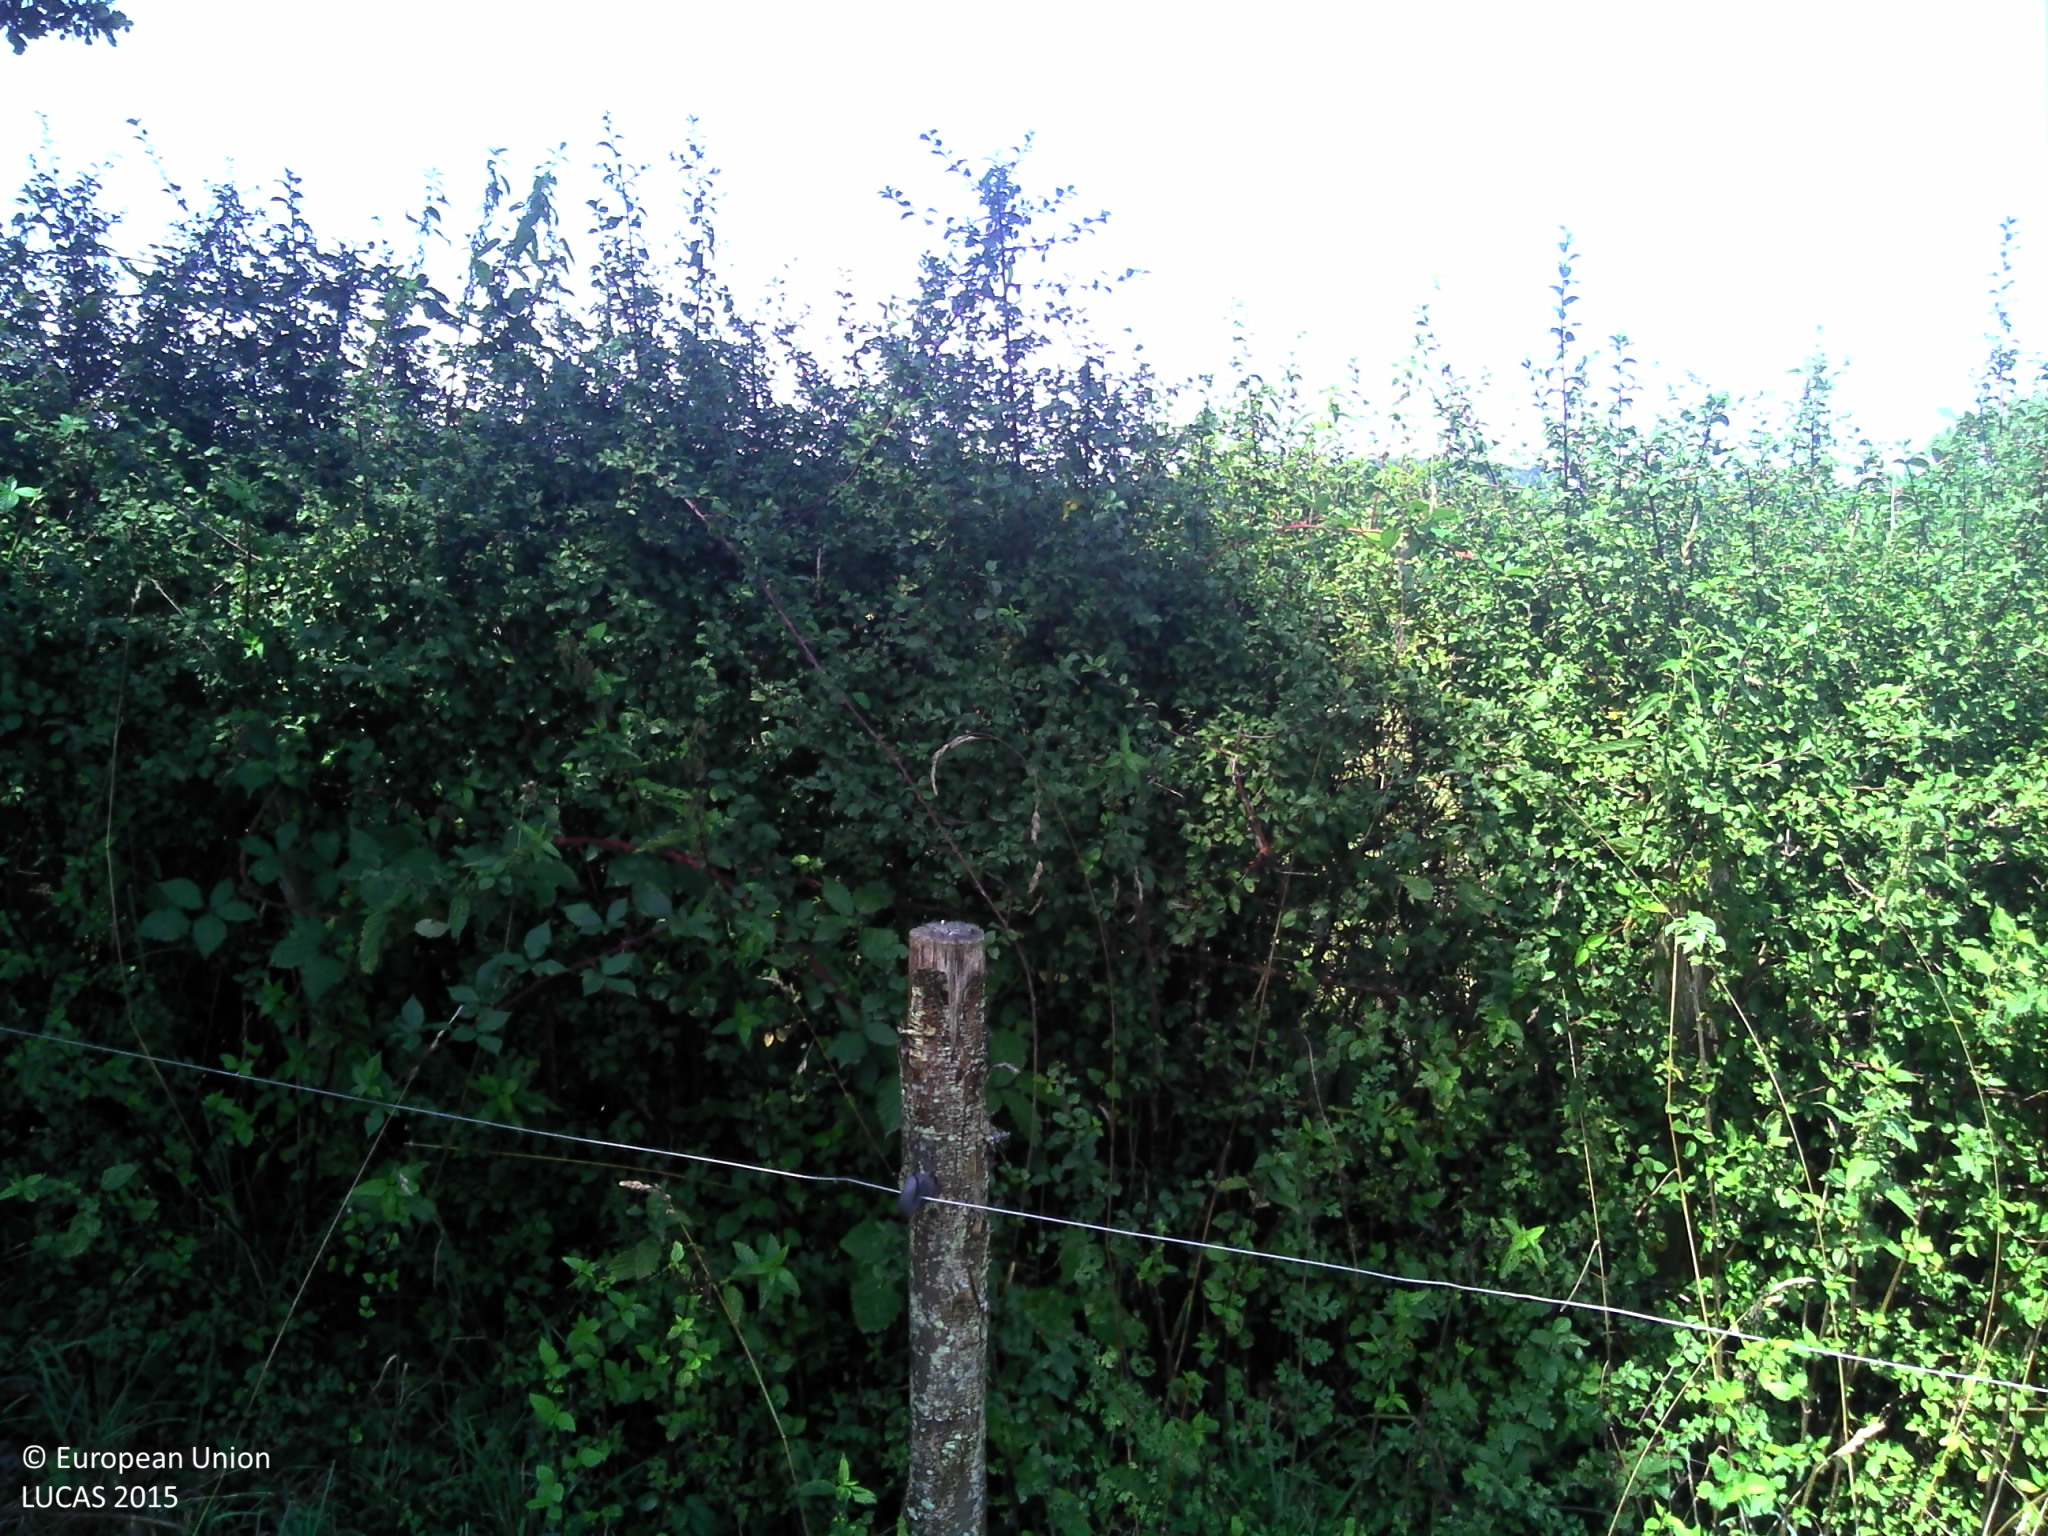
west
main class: Grassland
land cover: Grassland without tree/shrub cover
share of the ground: > 75 %
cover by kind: herbaceous plants 100 %
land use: Agriculture (excluding fallow land and kitchen gardens)
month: August
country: FR
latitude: 46.2596
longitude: 1.6497
